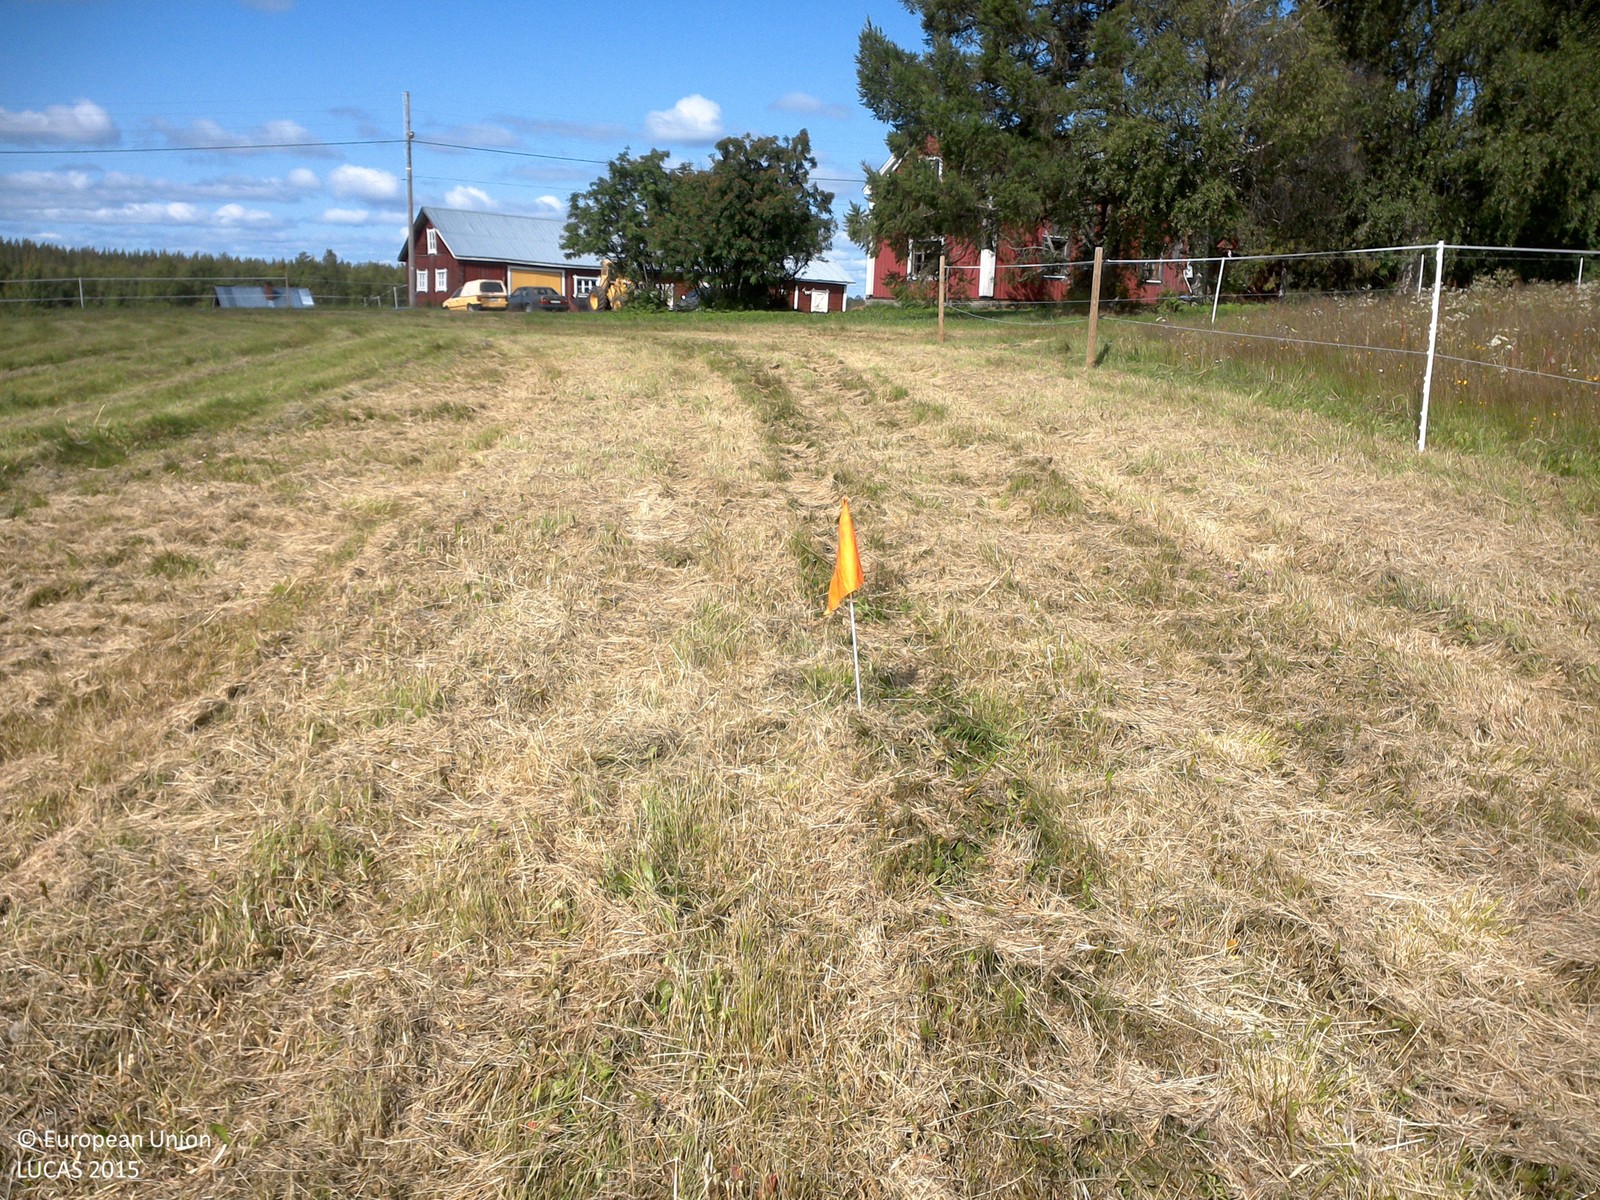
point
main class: Grassland
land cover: Grassland without tree/shrub cover
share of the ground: > 75 %
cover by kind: herbaceous plants 100 %
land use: Agriculture (excluding fallow land and kitchen gardens)
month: July
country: SE
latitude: 67.1780
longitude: 22.6478
